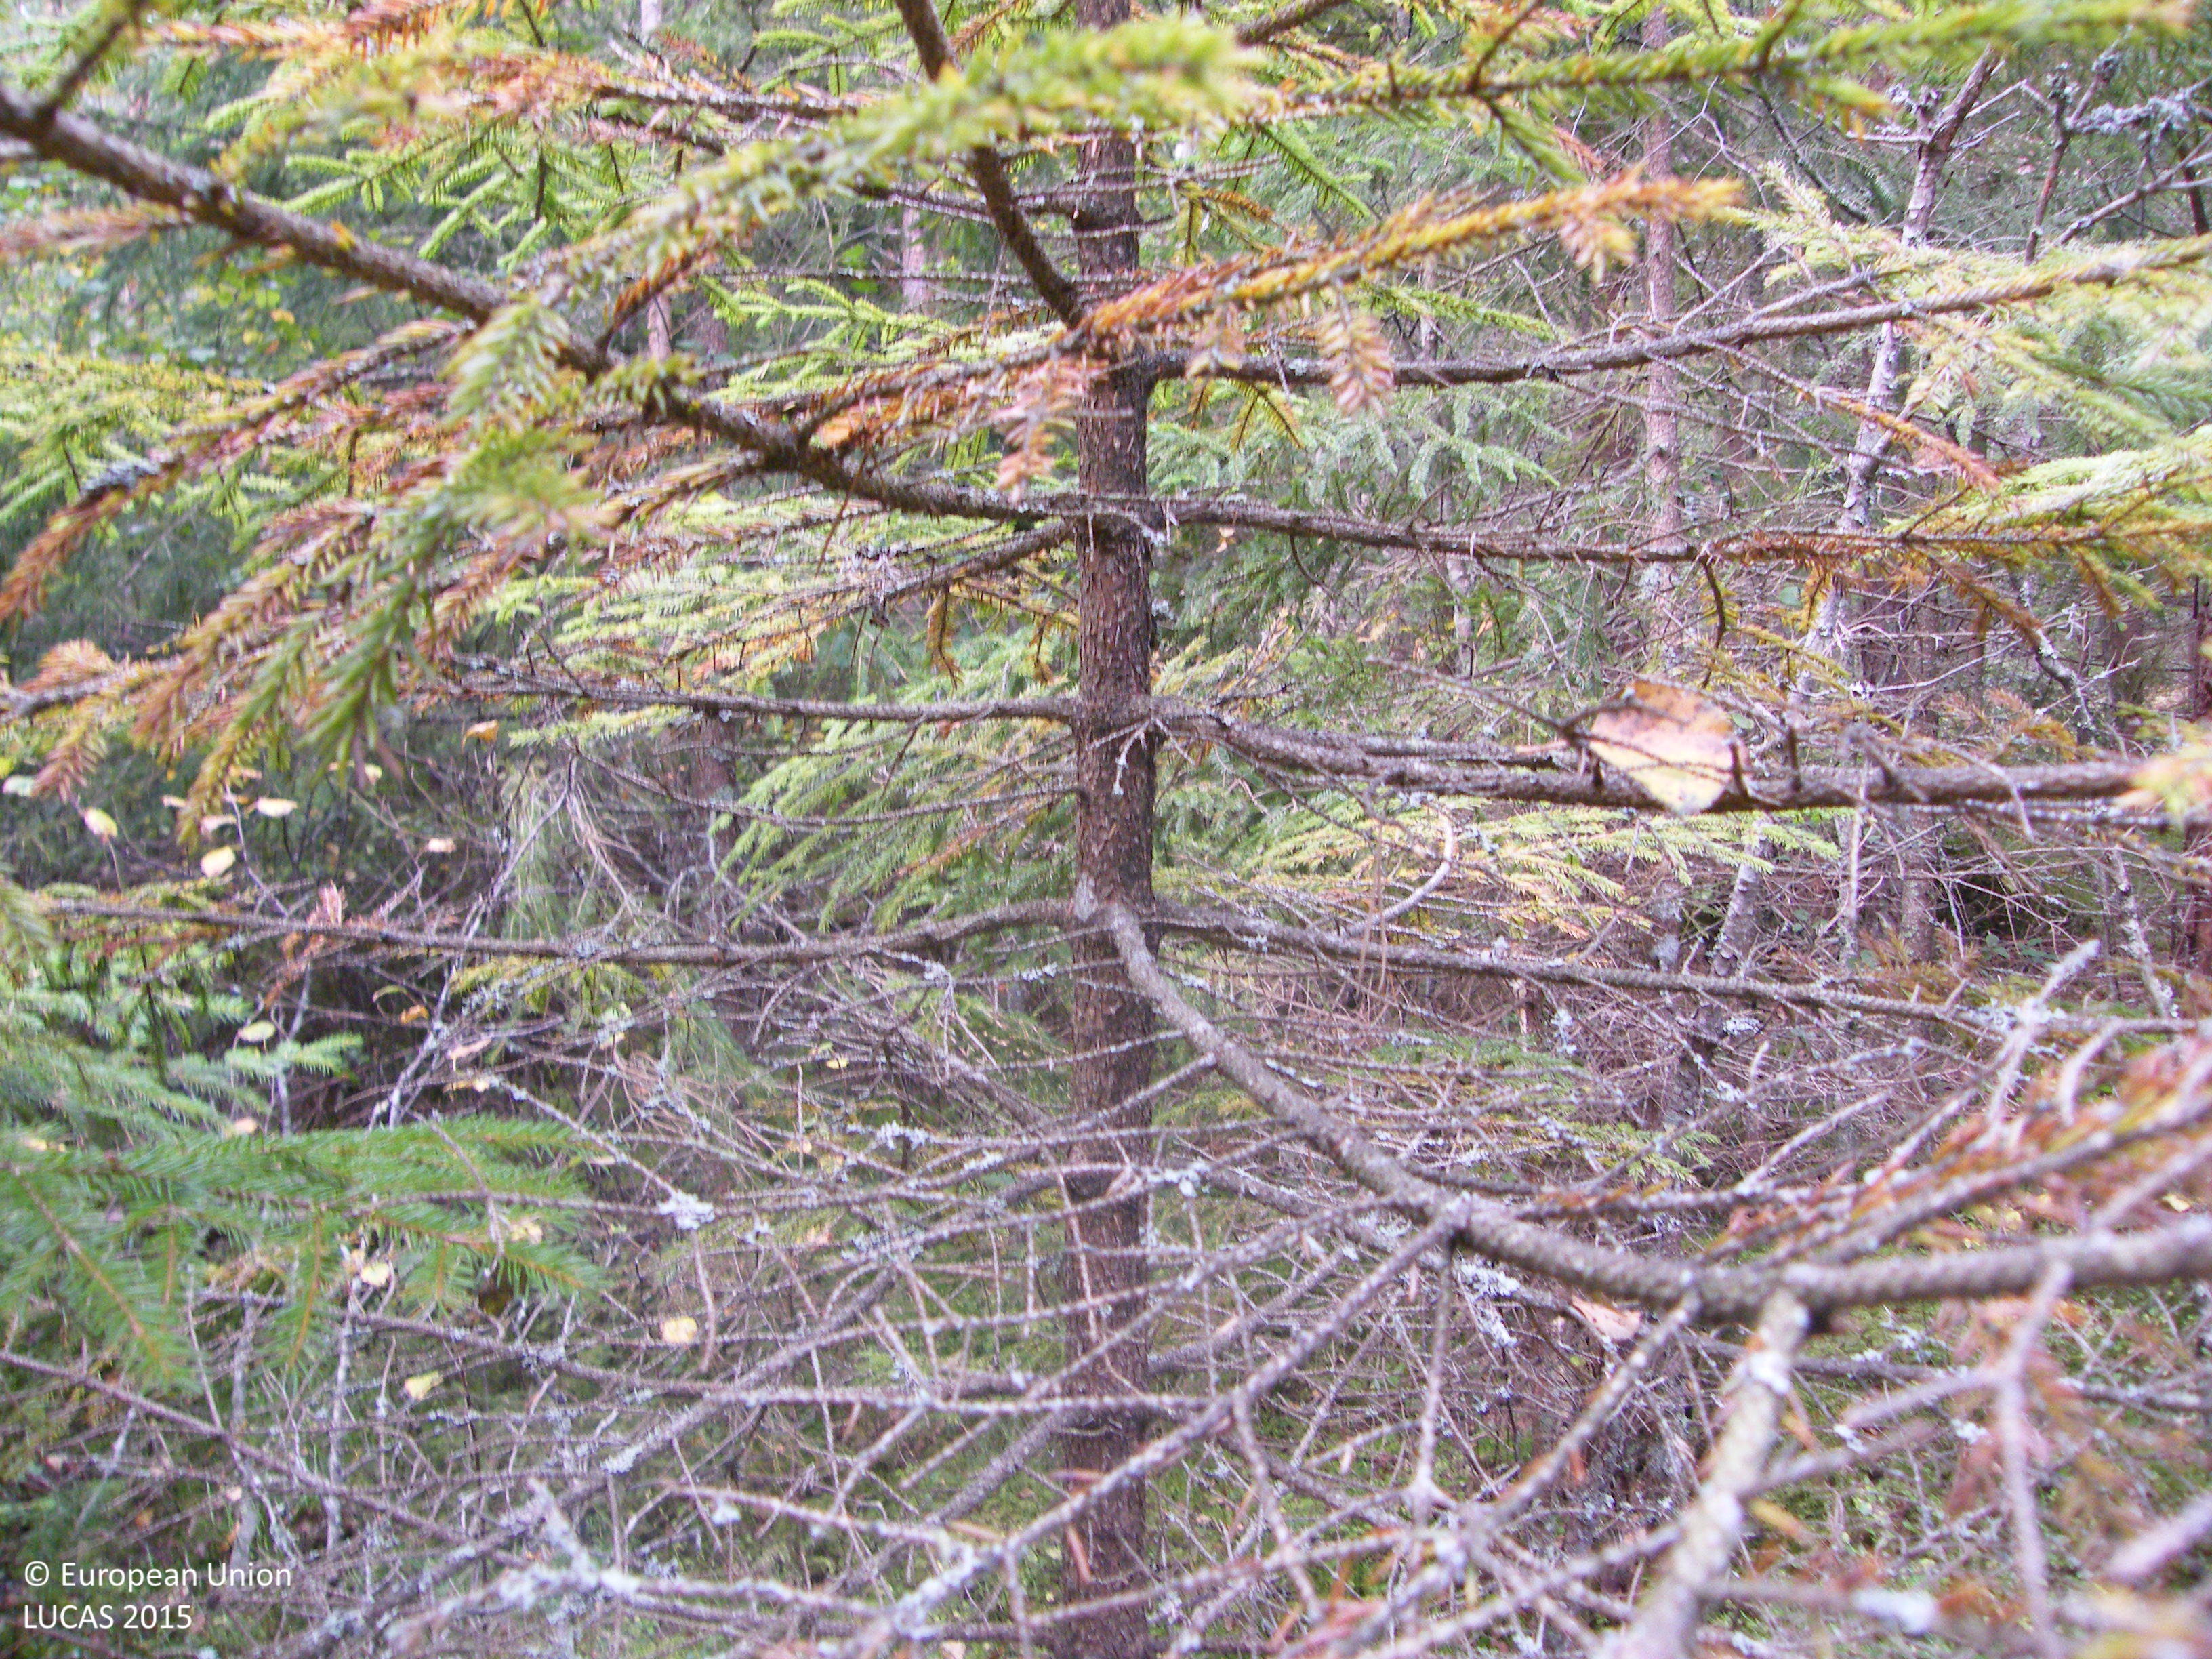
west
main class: Woodland
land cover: Other mixed woodland
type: boreal forest
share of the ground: > 75 %
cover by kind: coniferous forest trees 55 %, broadleaved forest trees 20 %, shrubs 15 %, lichens and mosses 10 %
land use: Forestry
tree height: > 5 m
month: September
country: SE
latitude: 59.4938
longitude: 15.5544
